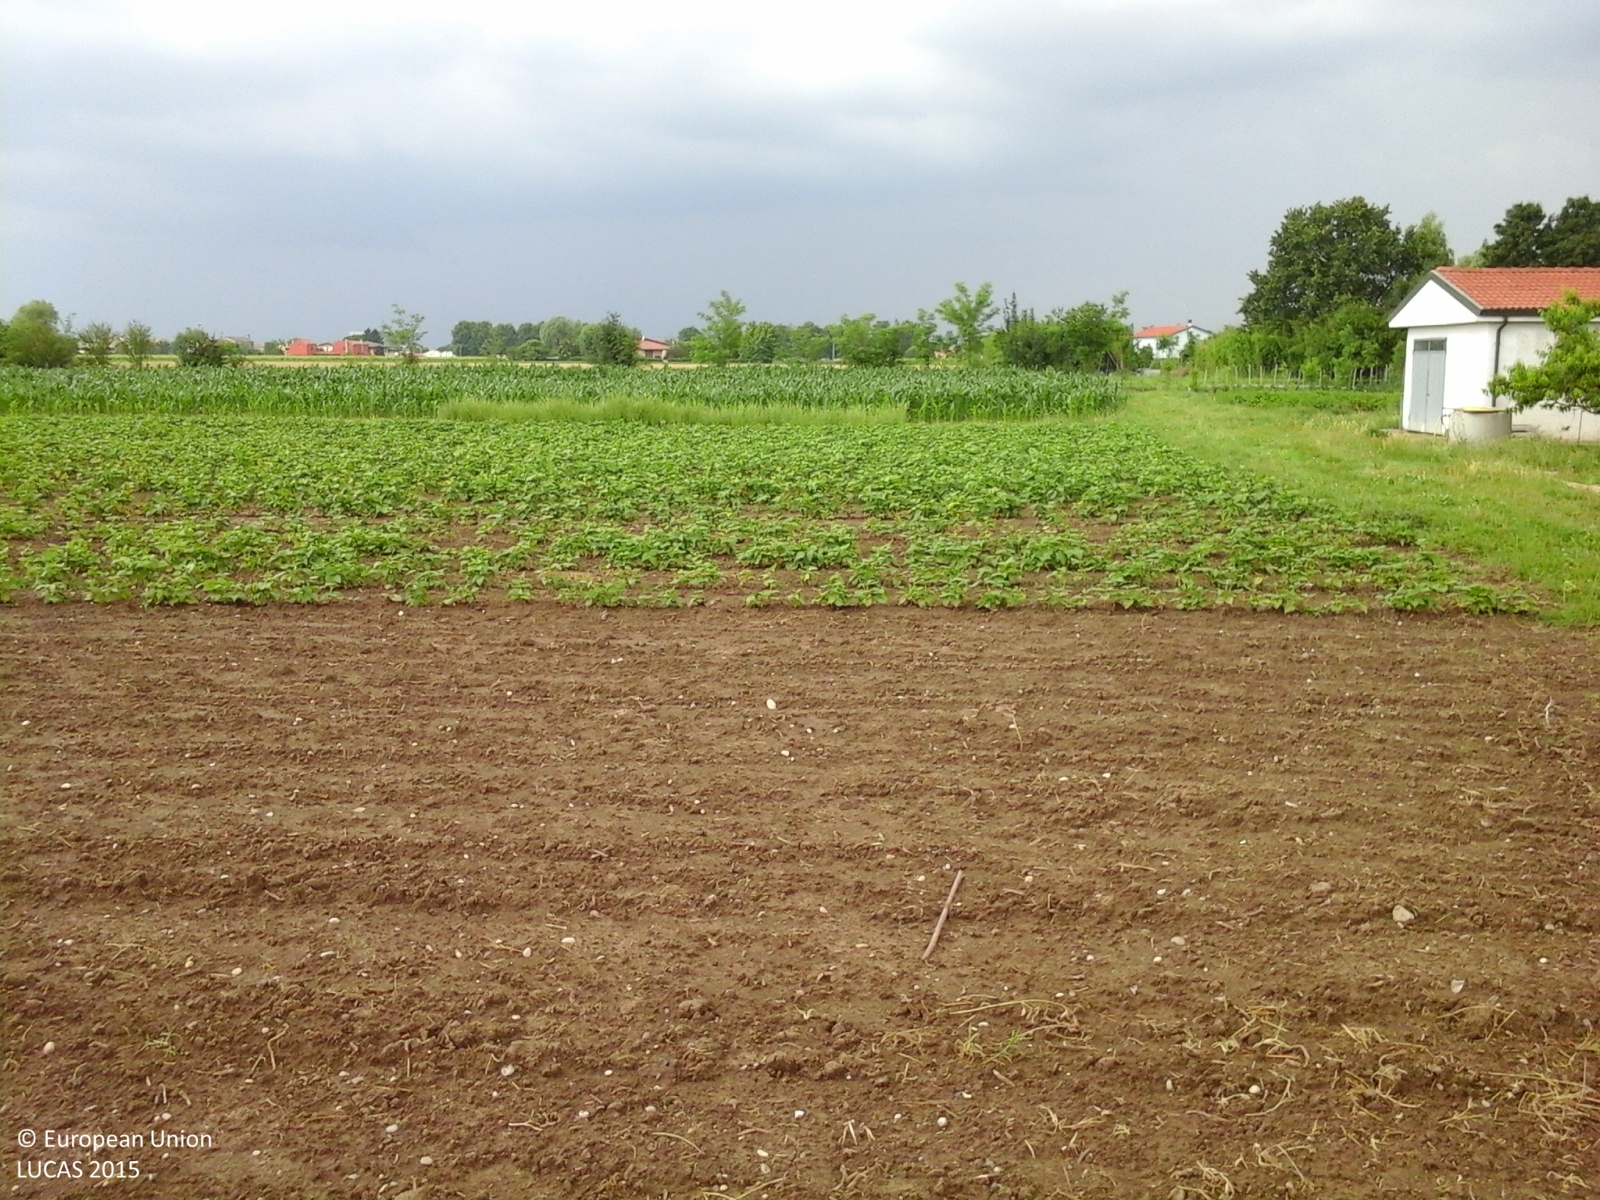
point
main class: Cropland
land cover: Potatoes
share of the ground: > 75 %
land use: Agriculture (excluding fallow land and kitchen gardens)
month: June
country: IT
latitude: 45.6719
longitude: 12.5509
